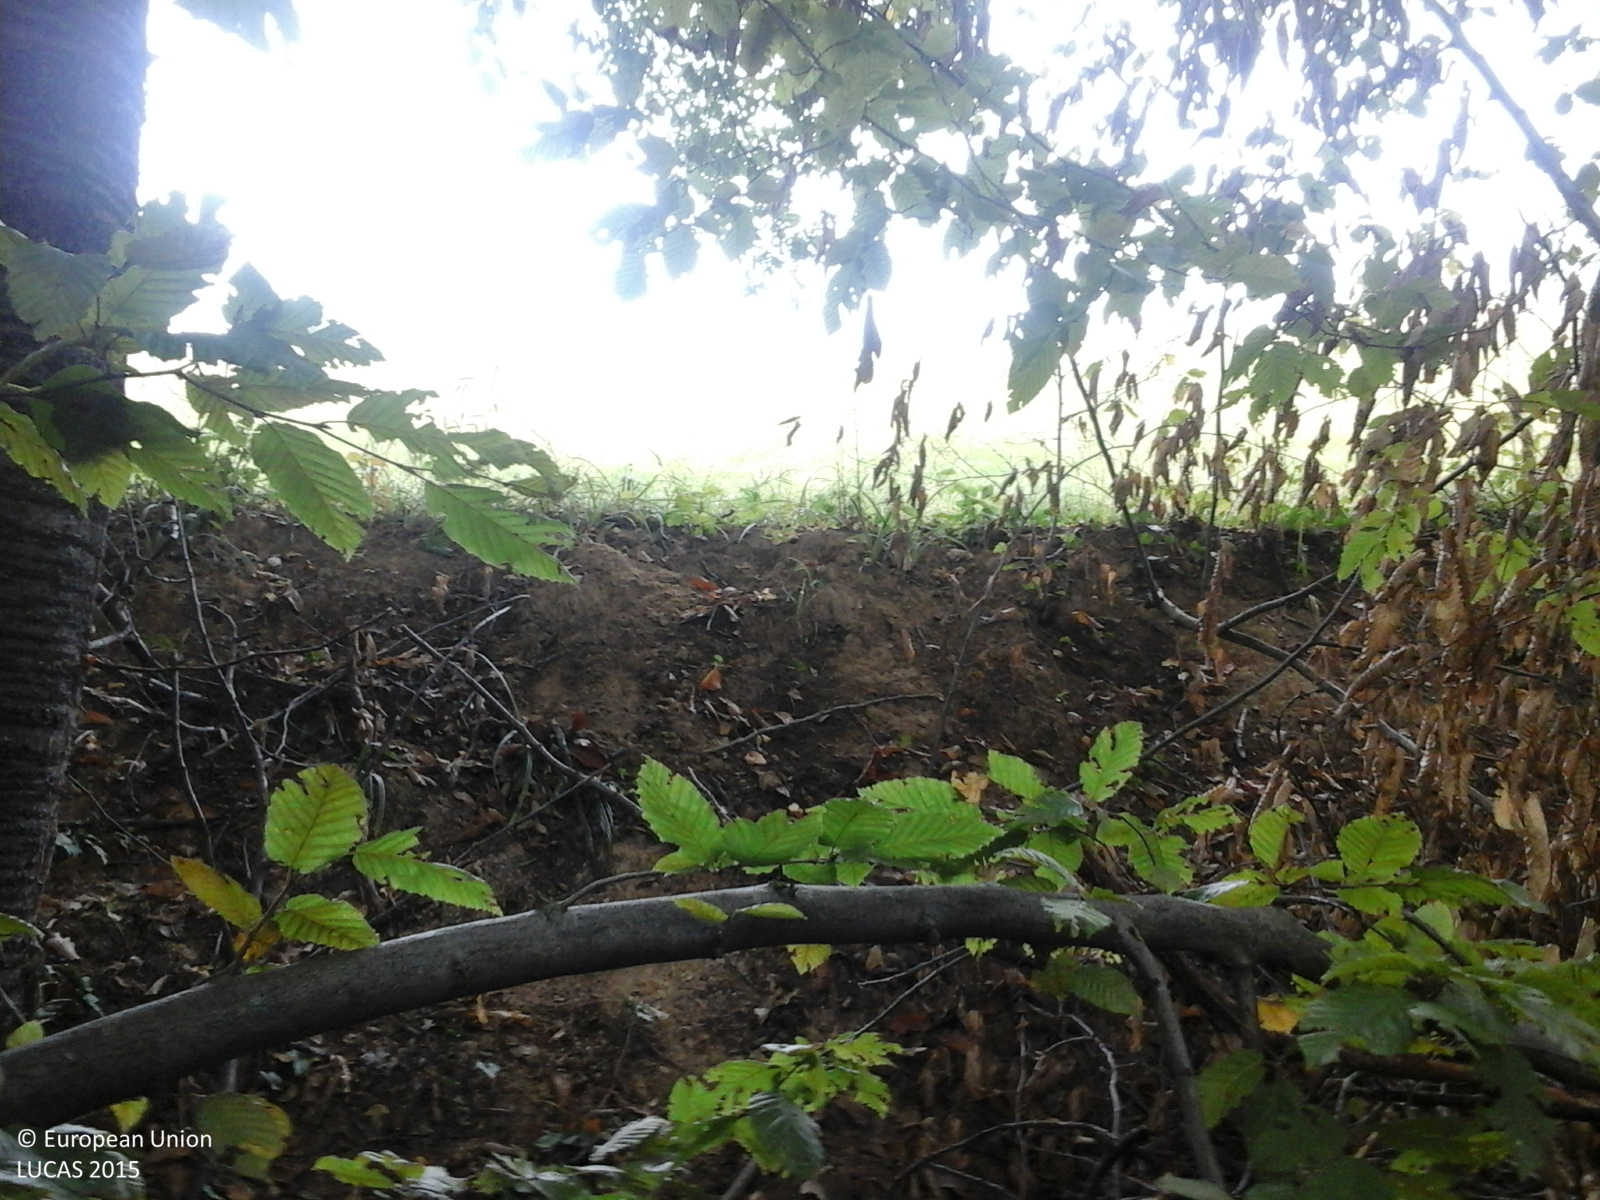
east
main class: Woodland
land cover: Broadleaved woodland
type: beech forest
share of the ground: > 75 %
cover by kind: broadleaved forest trees 100 %
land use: Forestry
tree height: > 5 m
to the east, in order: Broadleaved woodland; Grassland without tree/shrub cover; Single bushes/trees; Grassland without tree/shrub cover; Tracks; Grass margins; Fences; Spontaneously vegetated surfaces
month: September
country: RO
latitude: 46.9836
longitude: 22.3177
